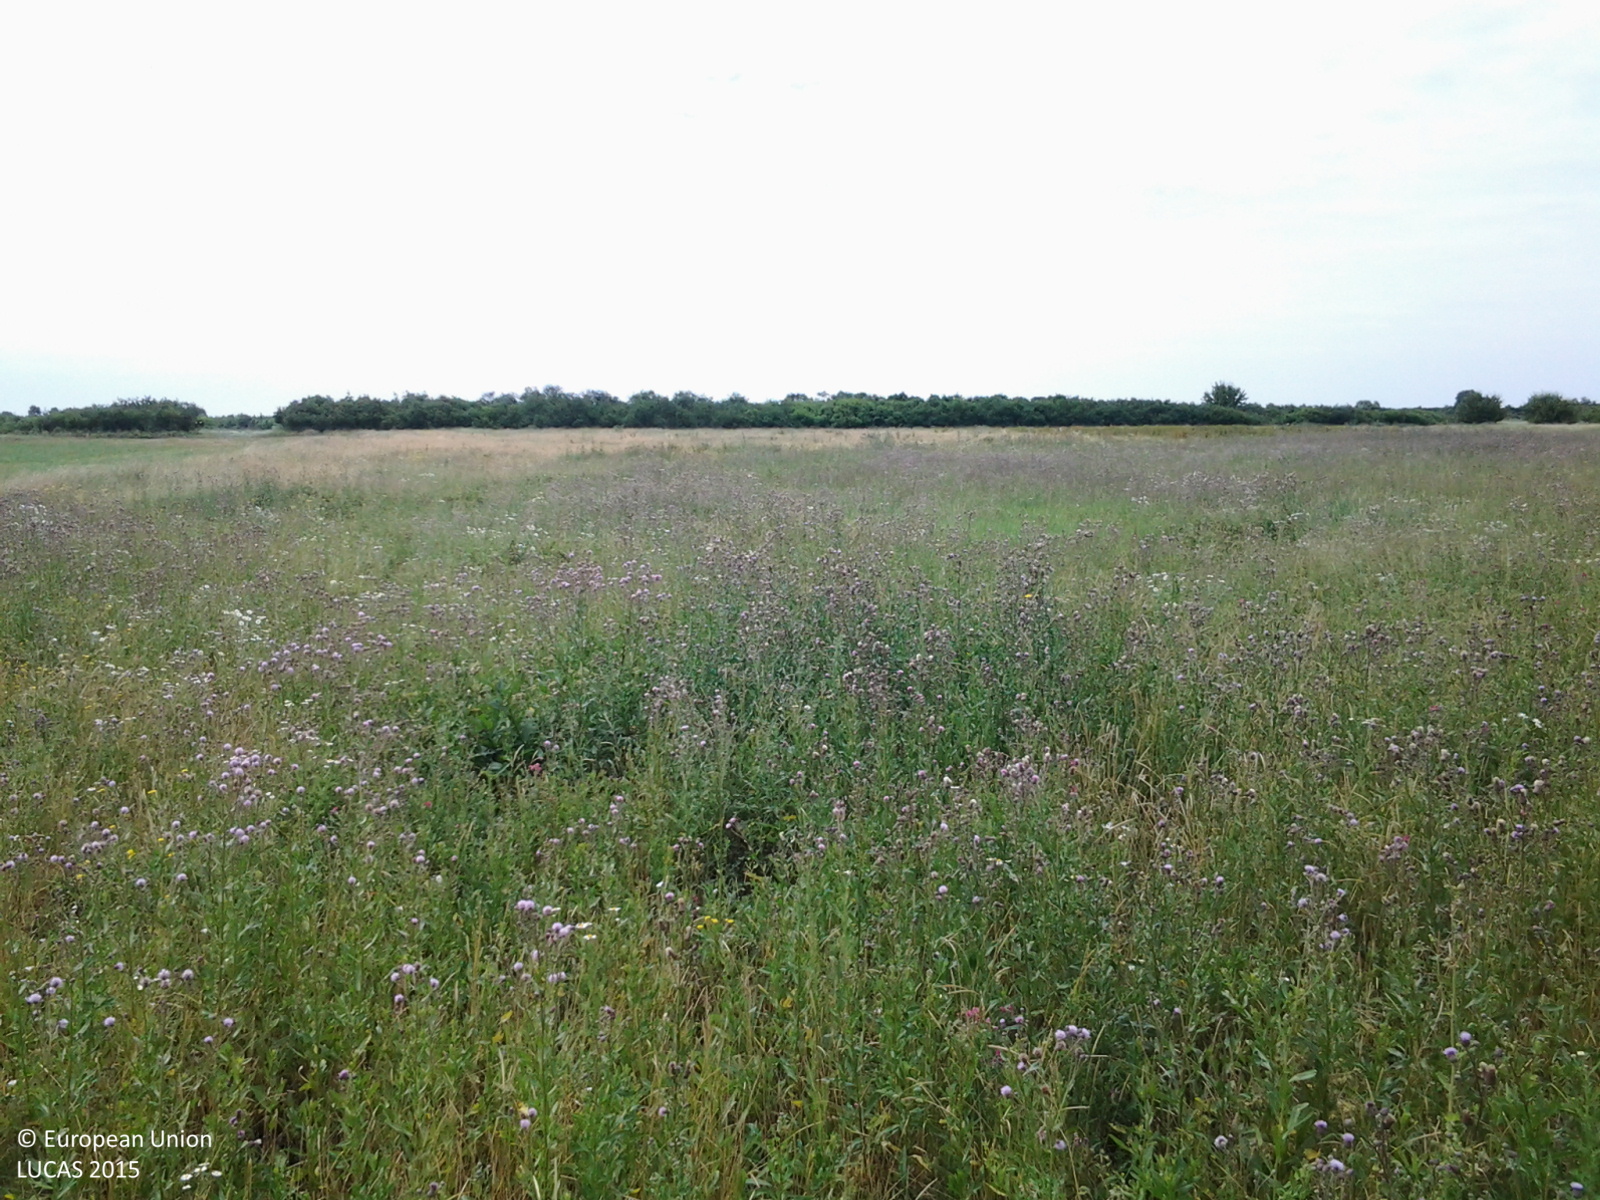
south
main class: Grassland
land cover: Grassland without tree/shrub cover
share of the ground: > 75 %
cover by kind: herbaceous plants 100 %
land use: Agriculture (excluding fallow land and kitchen gardens)
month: June
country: HU
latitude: 46.6317
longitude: 21.3878
